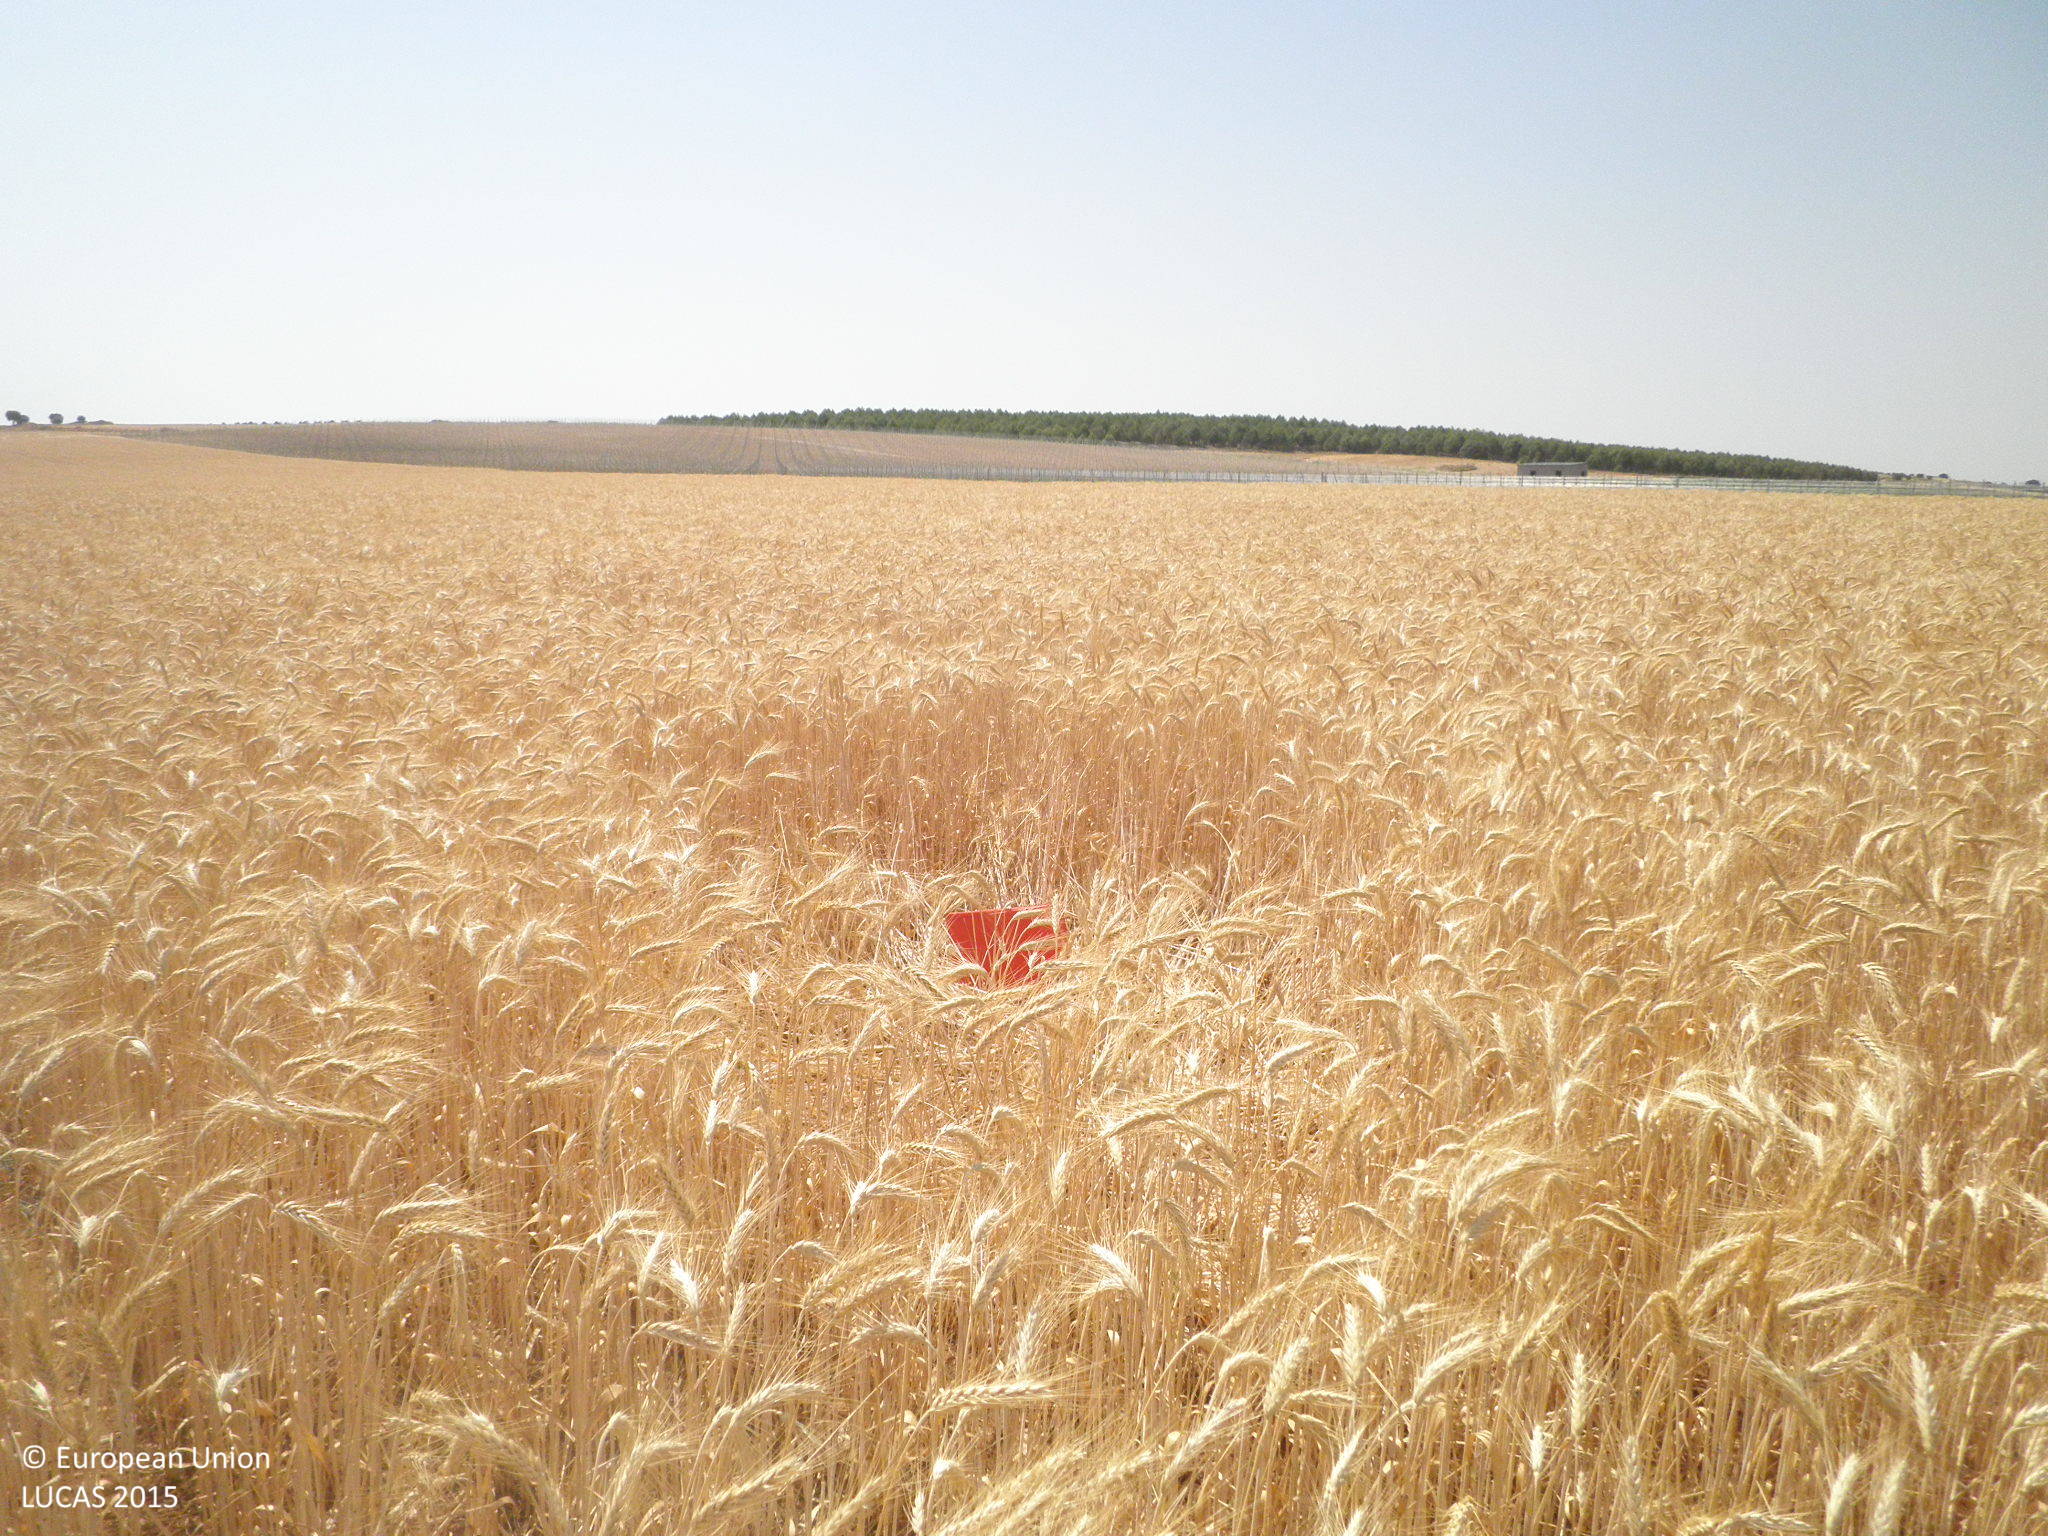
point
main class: Cropland
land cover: Durum wheat
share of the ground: > 75 %
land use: Agriculture (excluding fallow land and kitchen gardens)
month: July
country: ES
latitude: 39.4696
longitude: -2.6014
